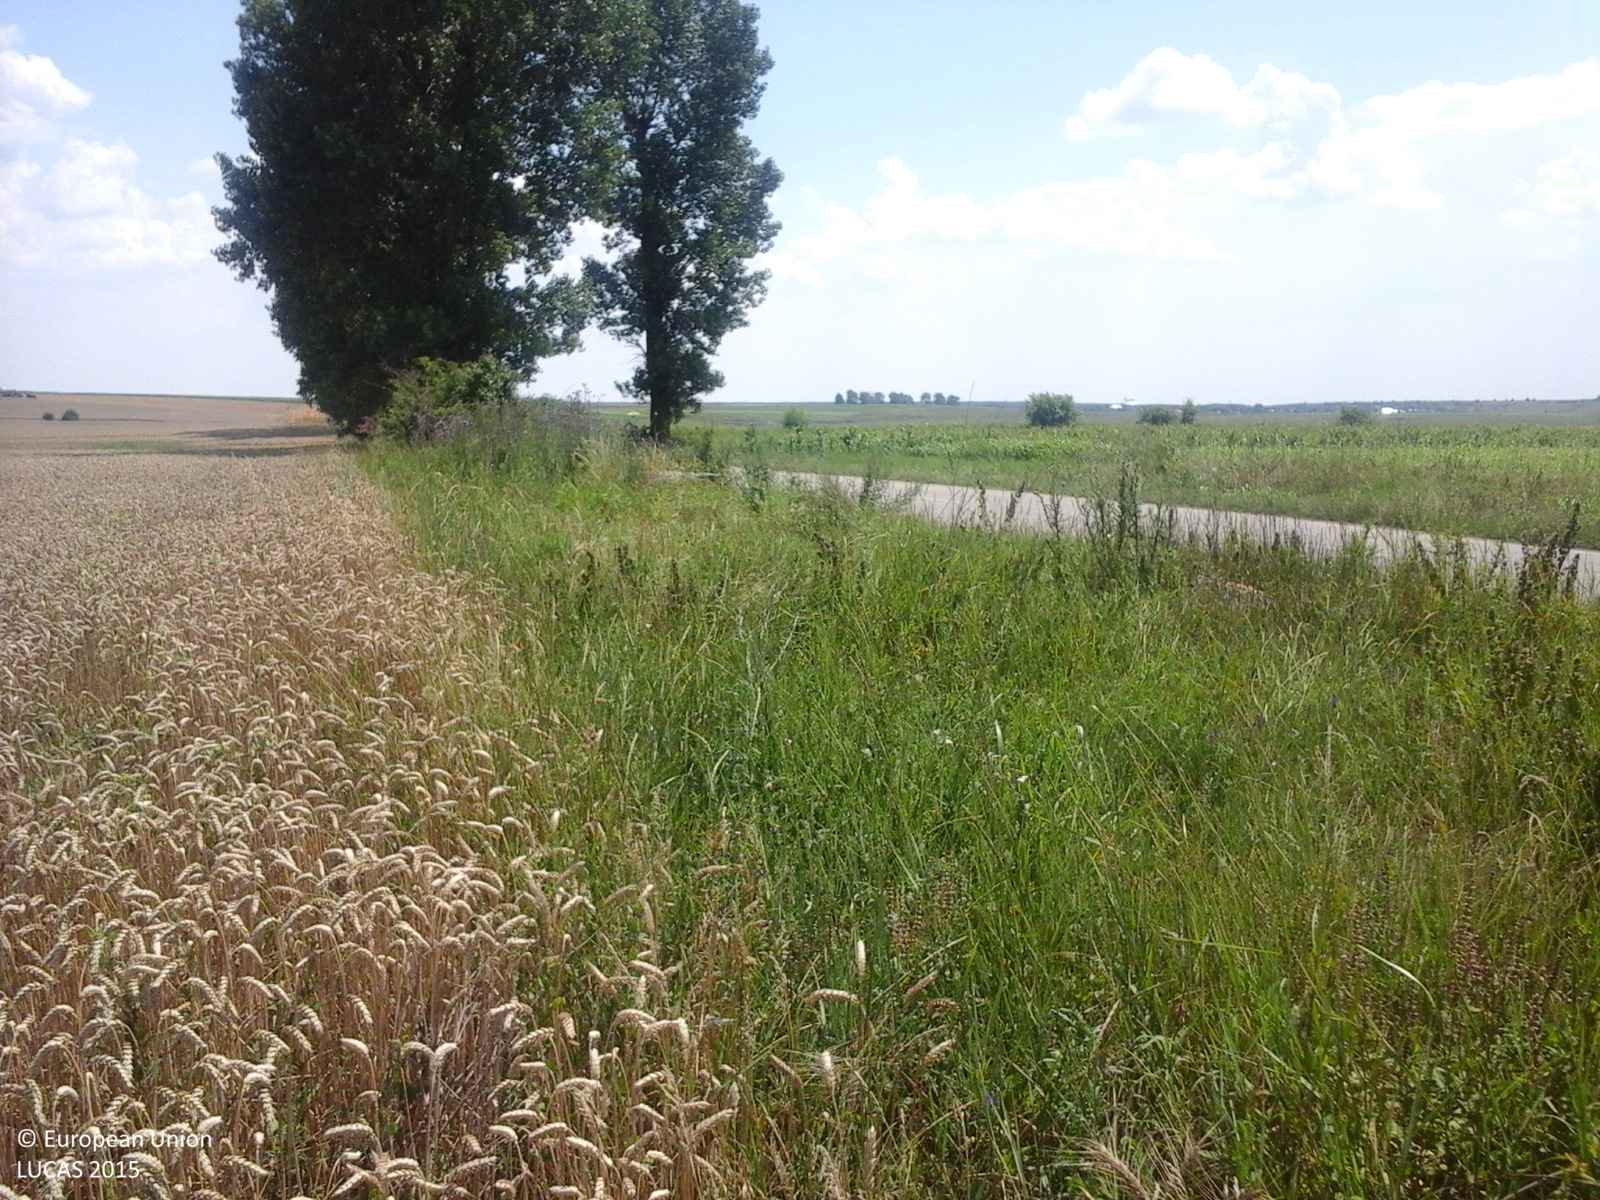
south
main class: Cropland
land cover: Common wheat
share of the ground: > 75 %
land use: Agriculture (excluding fallow land and kitchen gardens)
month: July
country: RO
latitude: 44.1153
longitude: 25.2389
